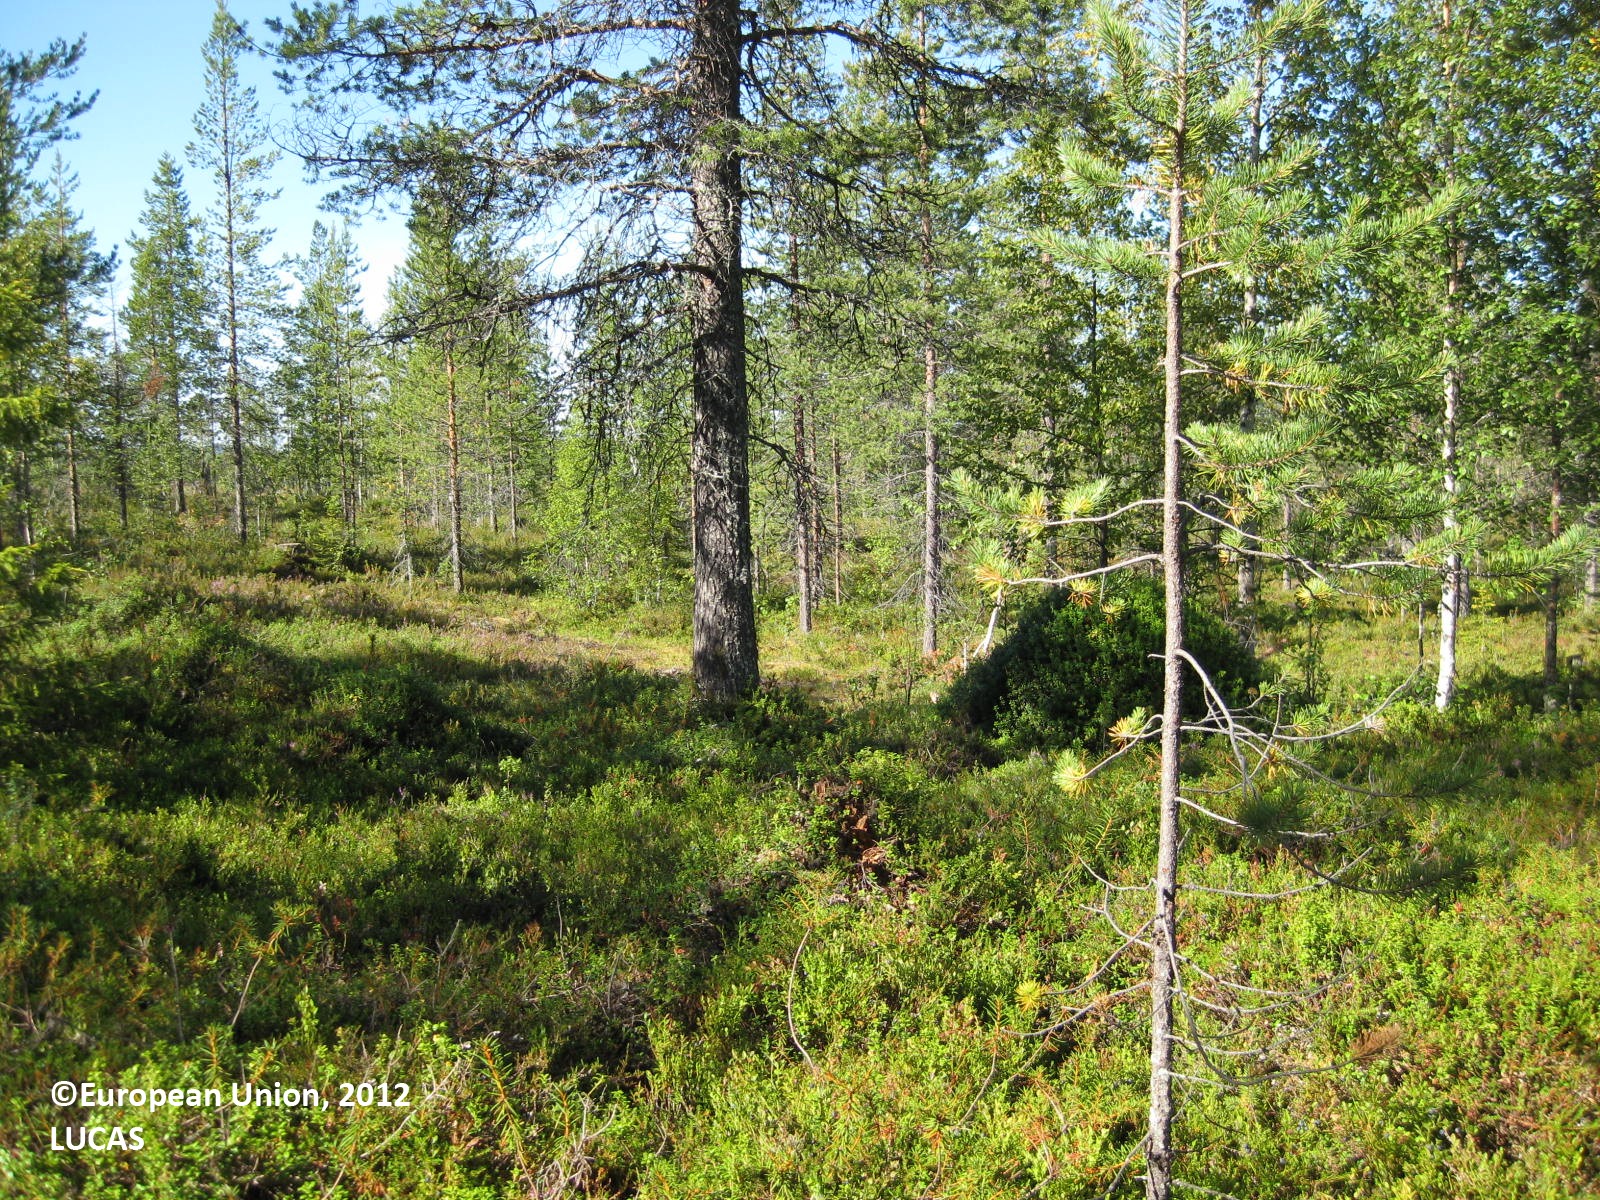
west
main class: Woodland
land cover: Pine dominated coniferous woodland
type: boreal forest
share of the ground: 50 - 75 %
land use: Forestry
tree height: > 5 m
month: August
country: FI
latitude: 66.5051
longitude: 28.5577
